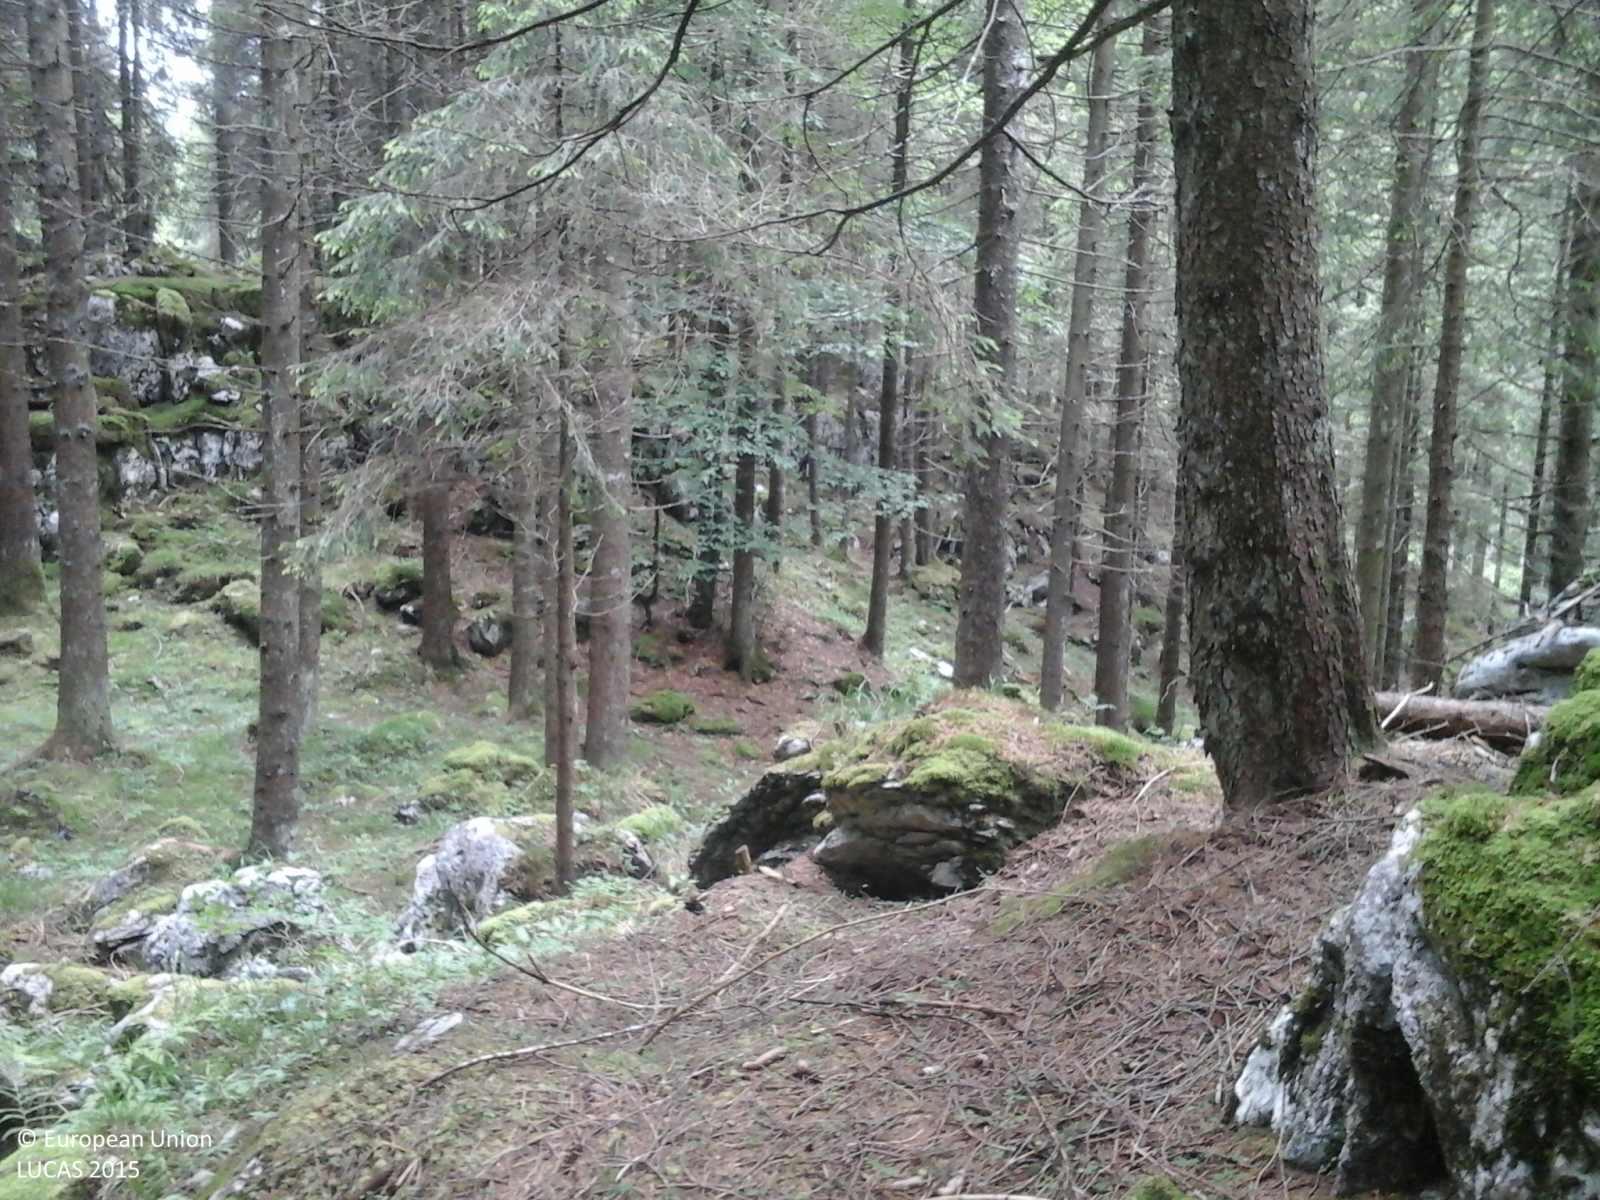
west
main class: Woodland
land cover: Spruce dominated mixed woodland
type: alpine coniferous forest
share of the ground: > 75 %
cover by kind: coniferous forest trees 75 %, broadleaved forest trees 25 %
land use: Forestry
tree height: > 5 m
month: June
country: IT
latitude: 45.8177
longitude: 11.5293
